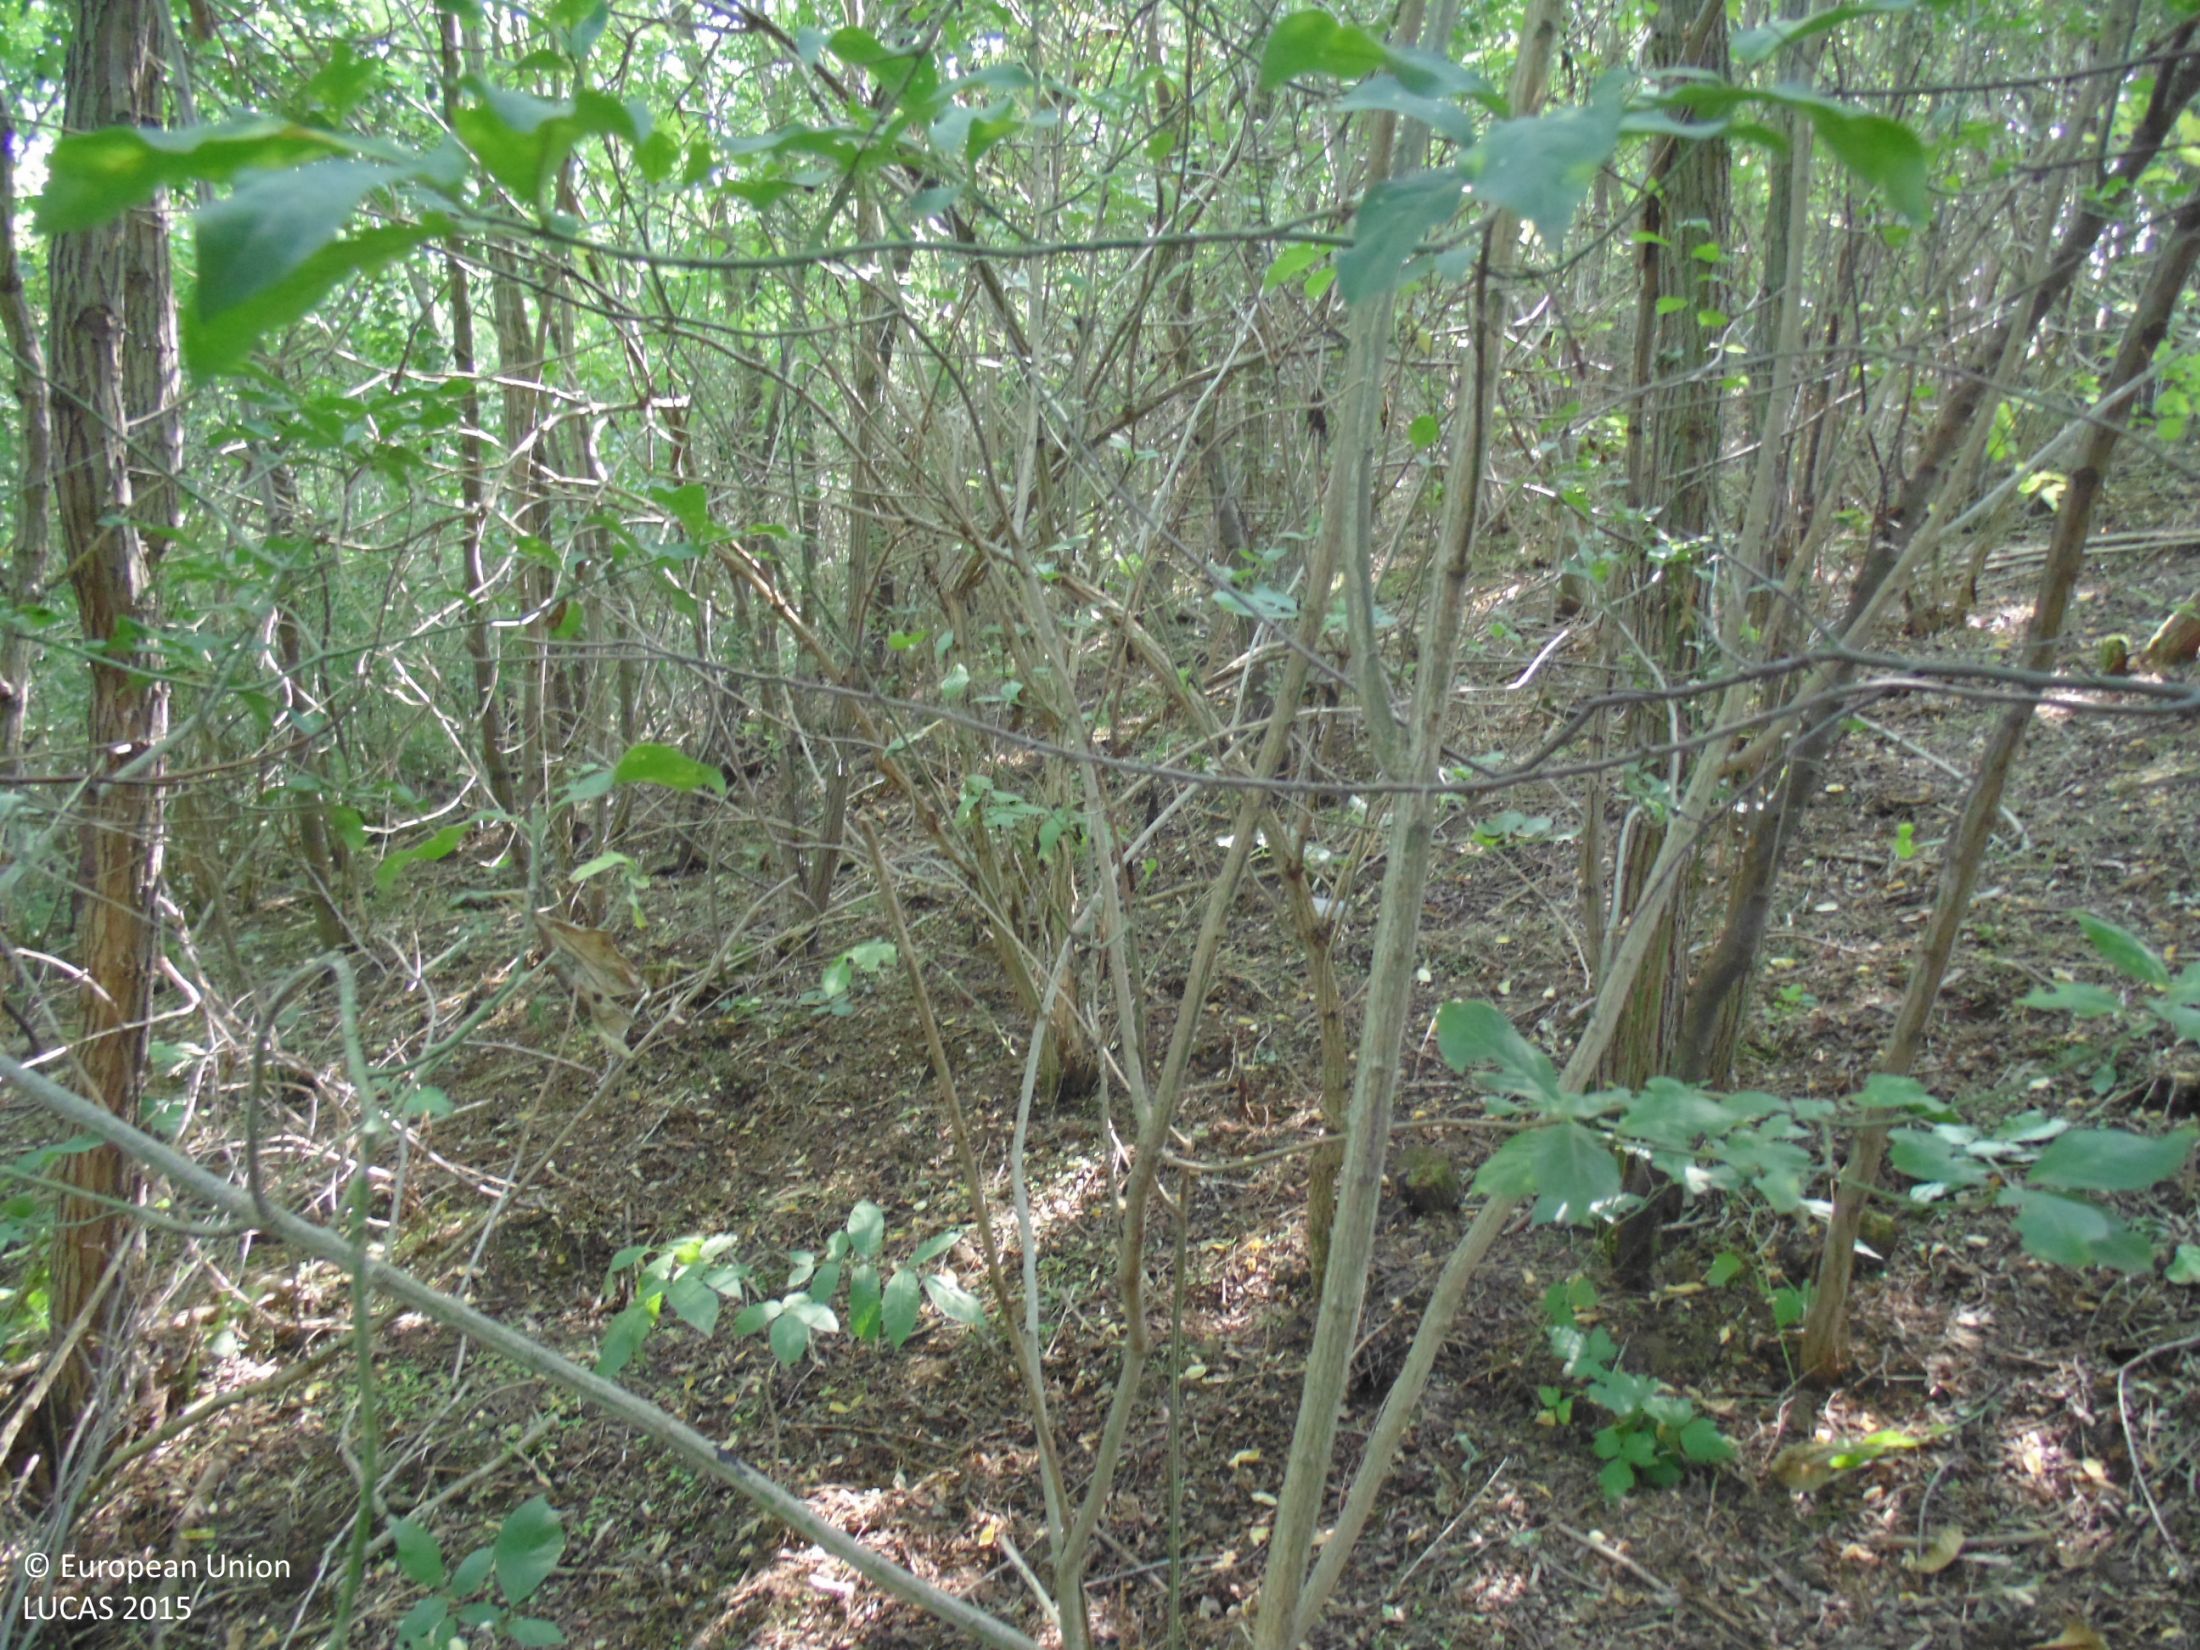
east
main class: Woodland
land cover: Broadleaved woodland
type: mesophytic deciduous forest
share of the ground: > 75 %
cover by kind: broadleaved forest trees 95 %, herbaceous plants 5 %
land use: Forestry
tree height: > 5 m
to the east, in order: Broadleaved woodland; Maize; Broadleaved woodland; Ditches and canals; Broadleaved woodland; Grass margins; Paved roads, cycling and walking lanes
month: August
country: BG
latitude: 44.0545
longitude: 27.3465
